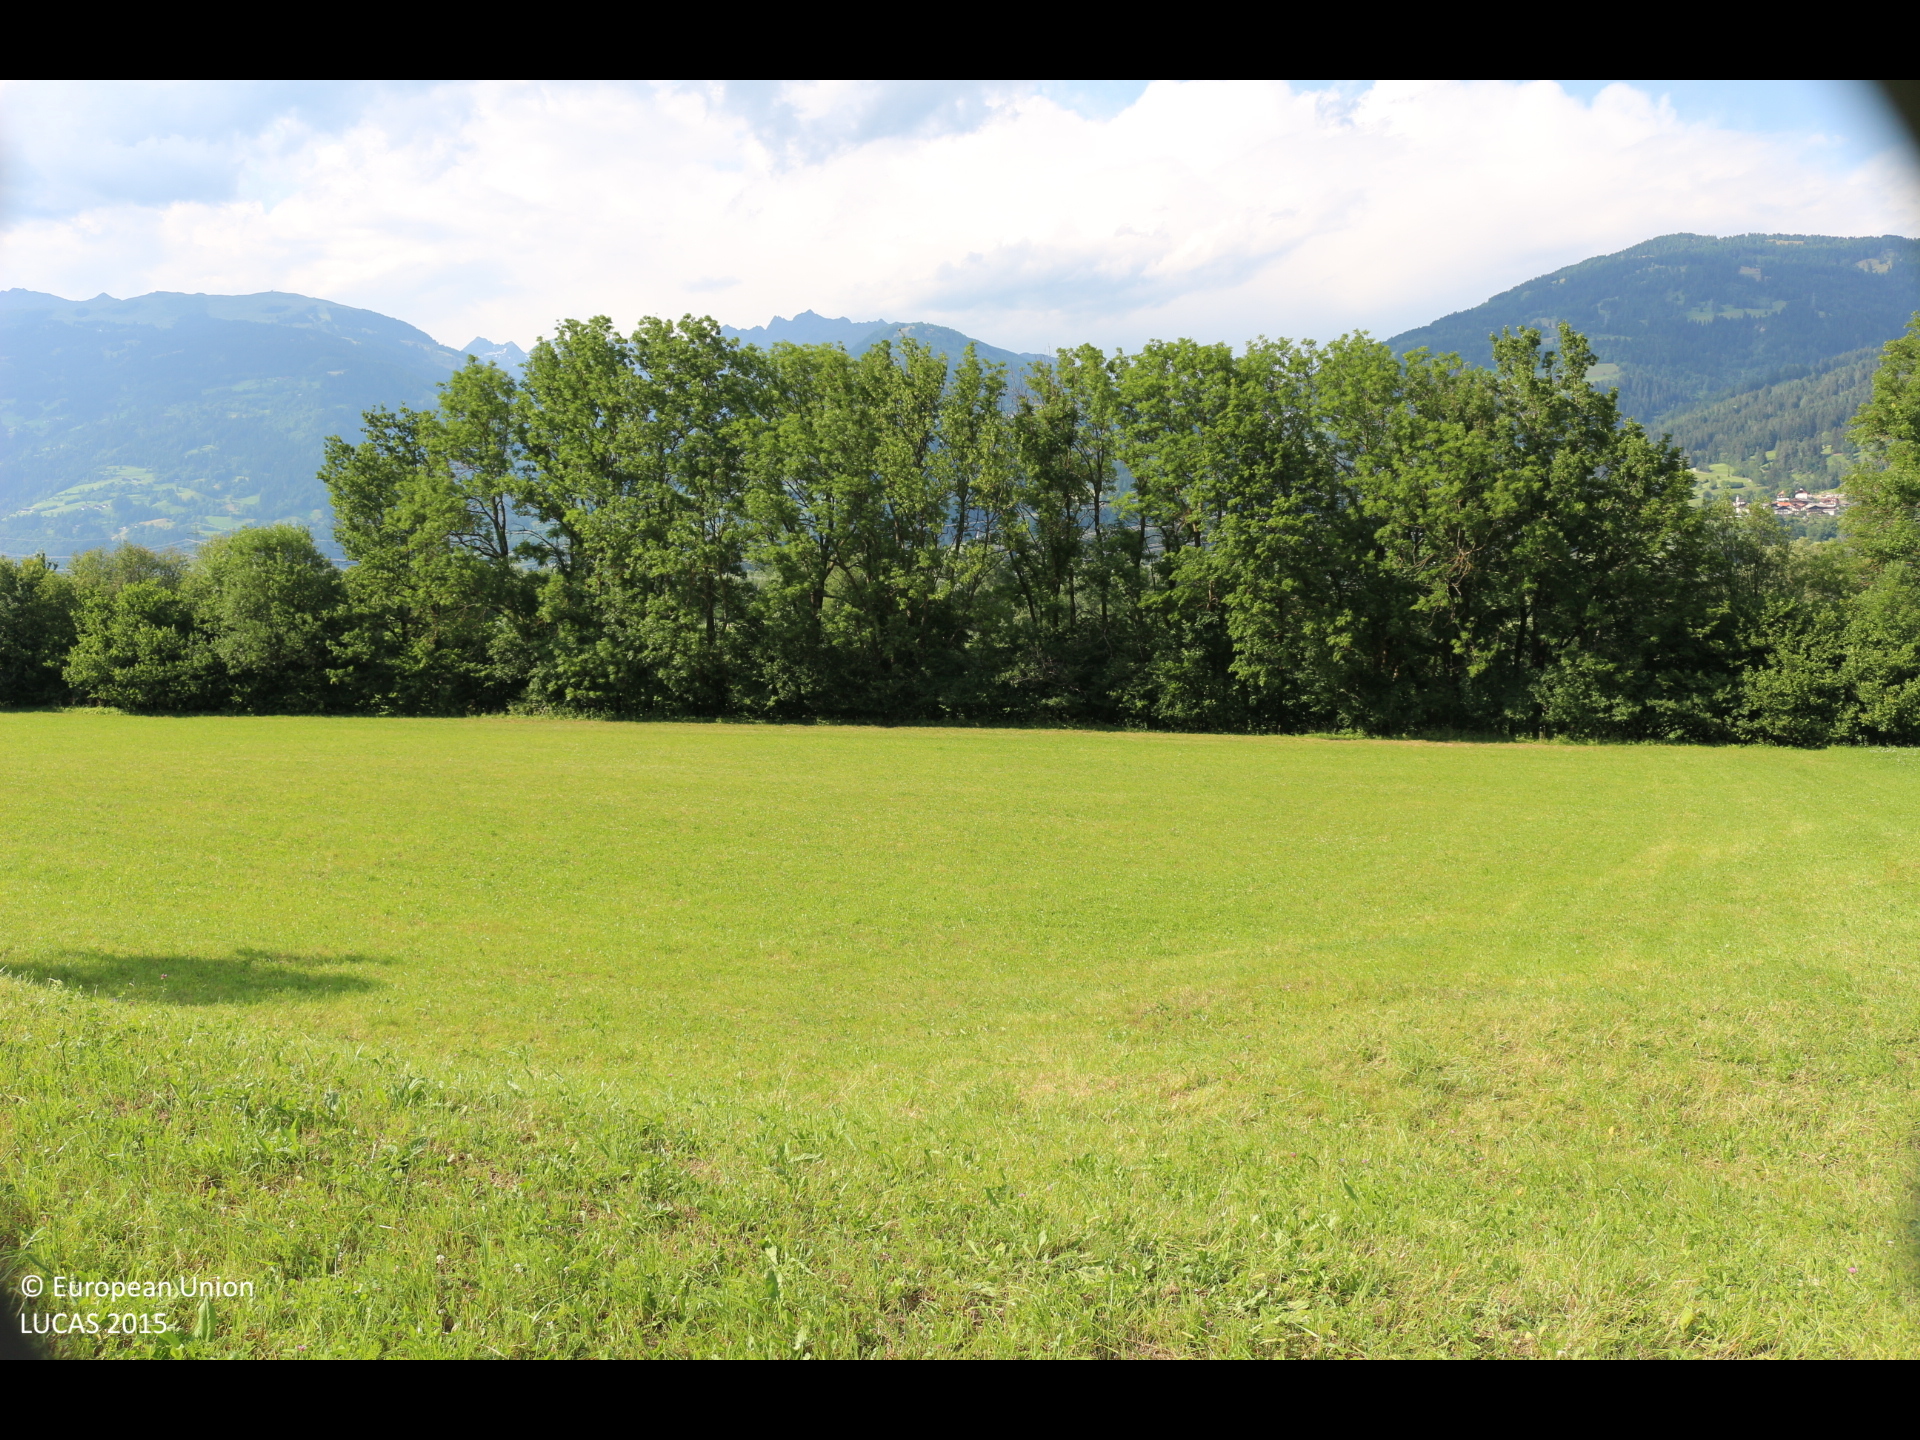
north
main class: Grassland
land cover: Grassland without tree/shrub cover
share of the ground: > 75 %
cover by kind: herbaceous plants 100 %
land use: Agriculture (excluding fallow land and kitchen gardens)
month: July
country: AT
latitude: 46.8001
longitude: 12.8407
